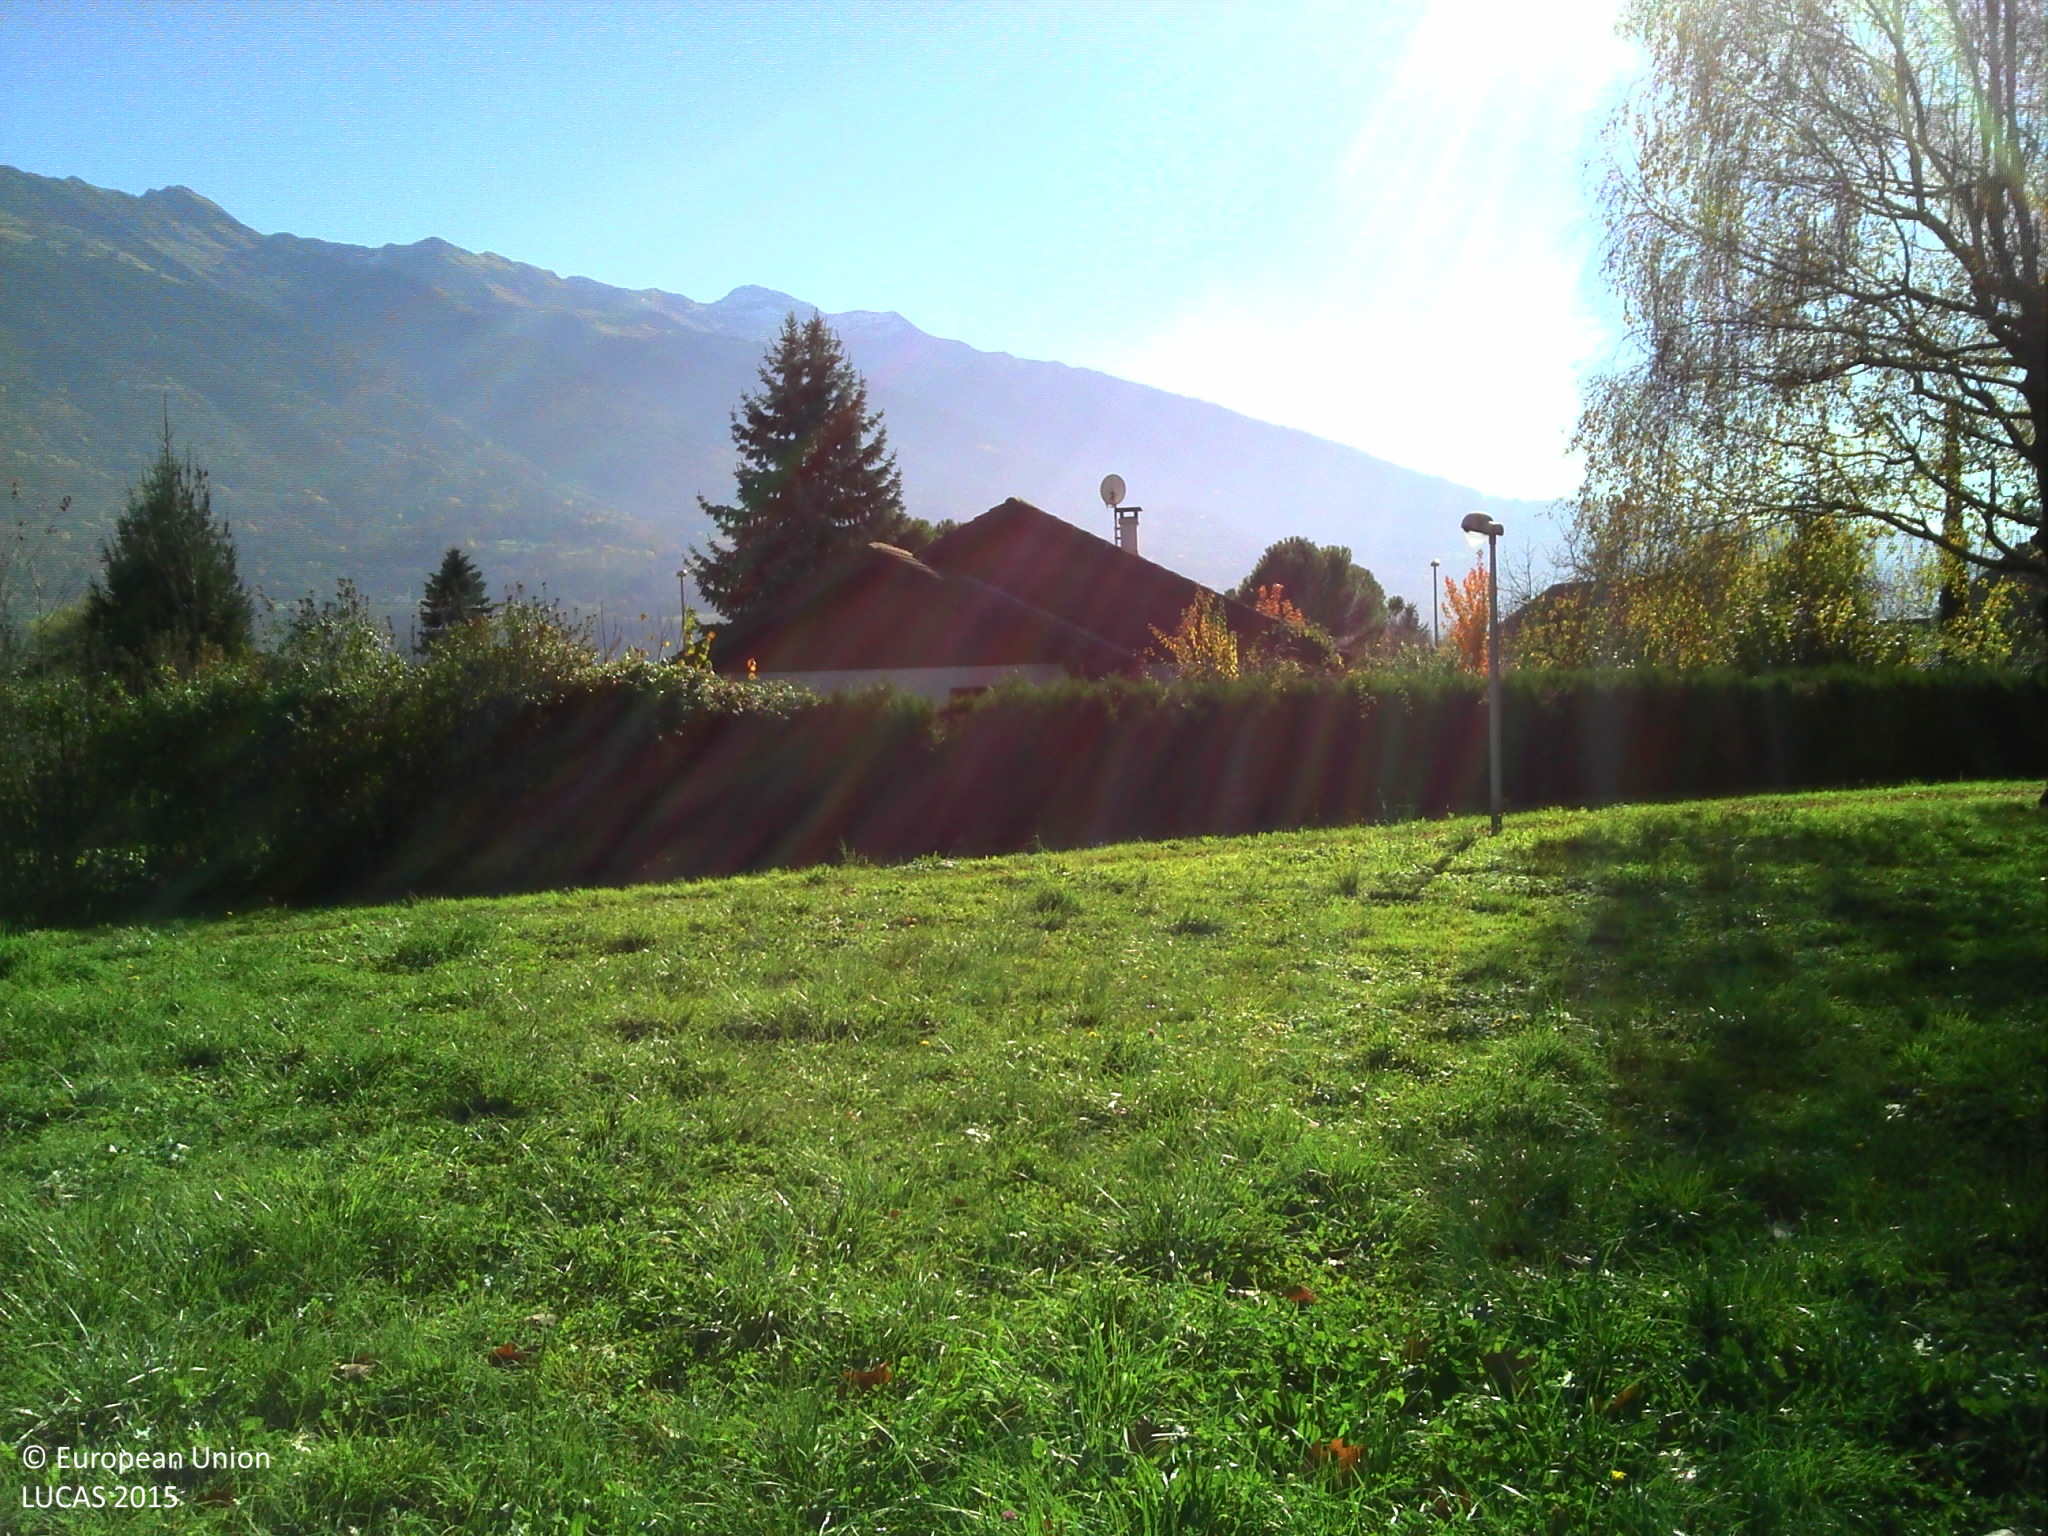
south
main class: Grassland
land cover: Grassland with sparse tree/shrub cover
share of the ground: > 75 %
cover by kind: herbaceous plants 95 %, broadleaved forest trees 5 %
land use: Amenities, museums, leisure
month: November
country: FR
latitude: 45.6577
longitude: 6.3468
